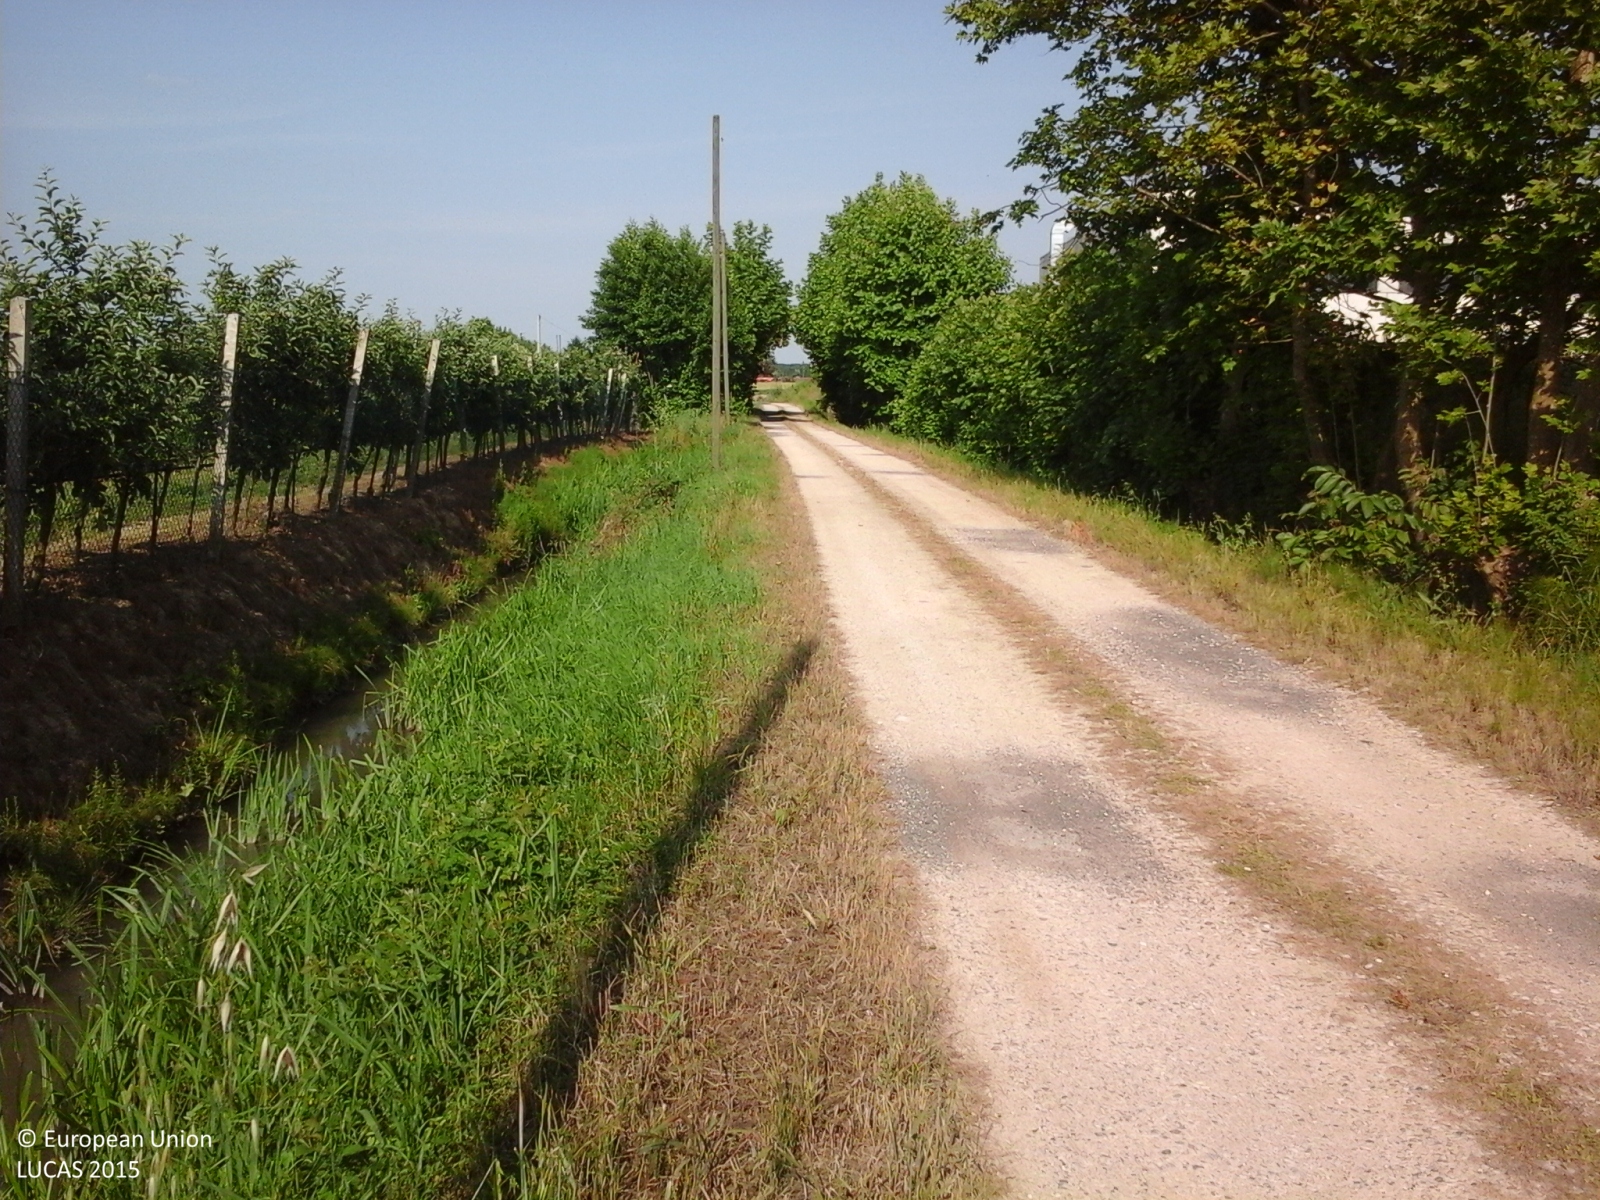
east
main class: Cropland
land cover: Apple fruit
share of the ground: 25 - 50 %
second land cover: Grassland without tree/shrub cover
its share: > 75 %
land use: Agriculture (excluding fallow land and kitchen gardens)
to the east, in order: Apple fruit; Grassland without tree/shrub cover; Fences; Ditches and canals; Soya; Paved roads, cycling and walking lanes; Grass margins; Common wheat; Ditches and canals; Artificial constructions in urban areas; Ditches and canals; Common wheat
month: May
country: IT
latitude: 45.2475
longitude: 10.9793
